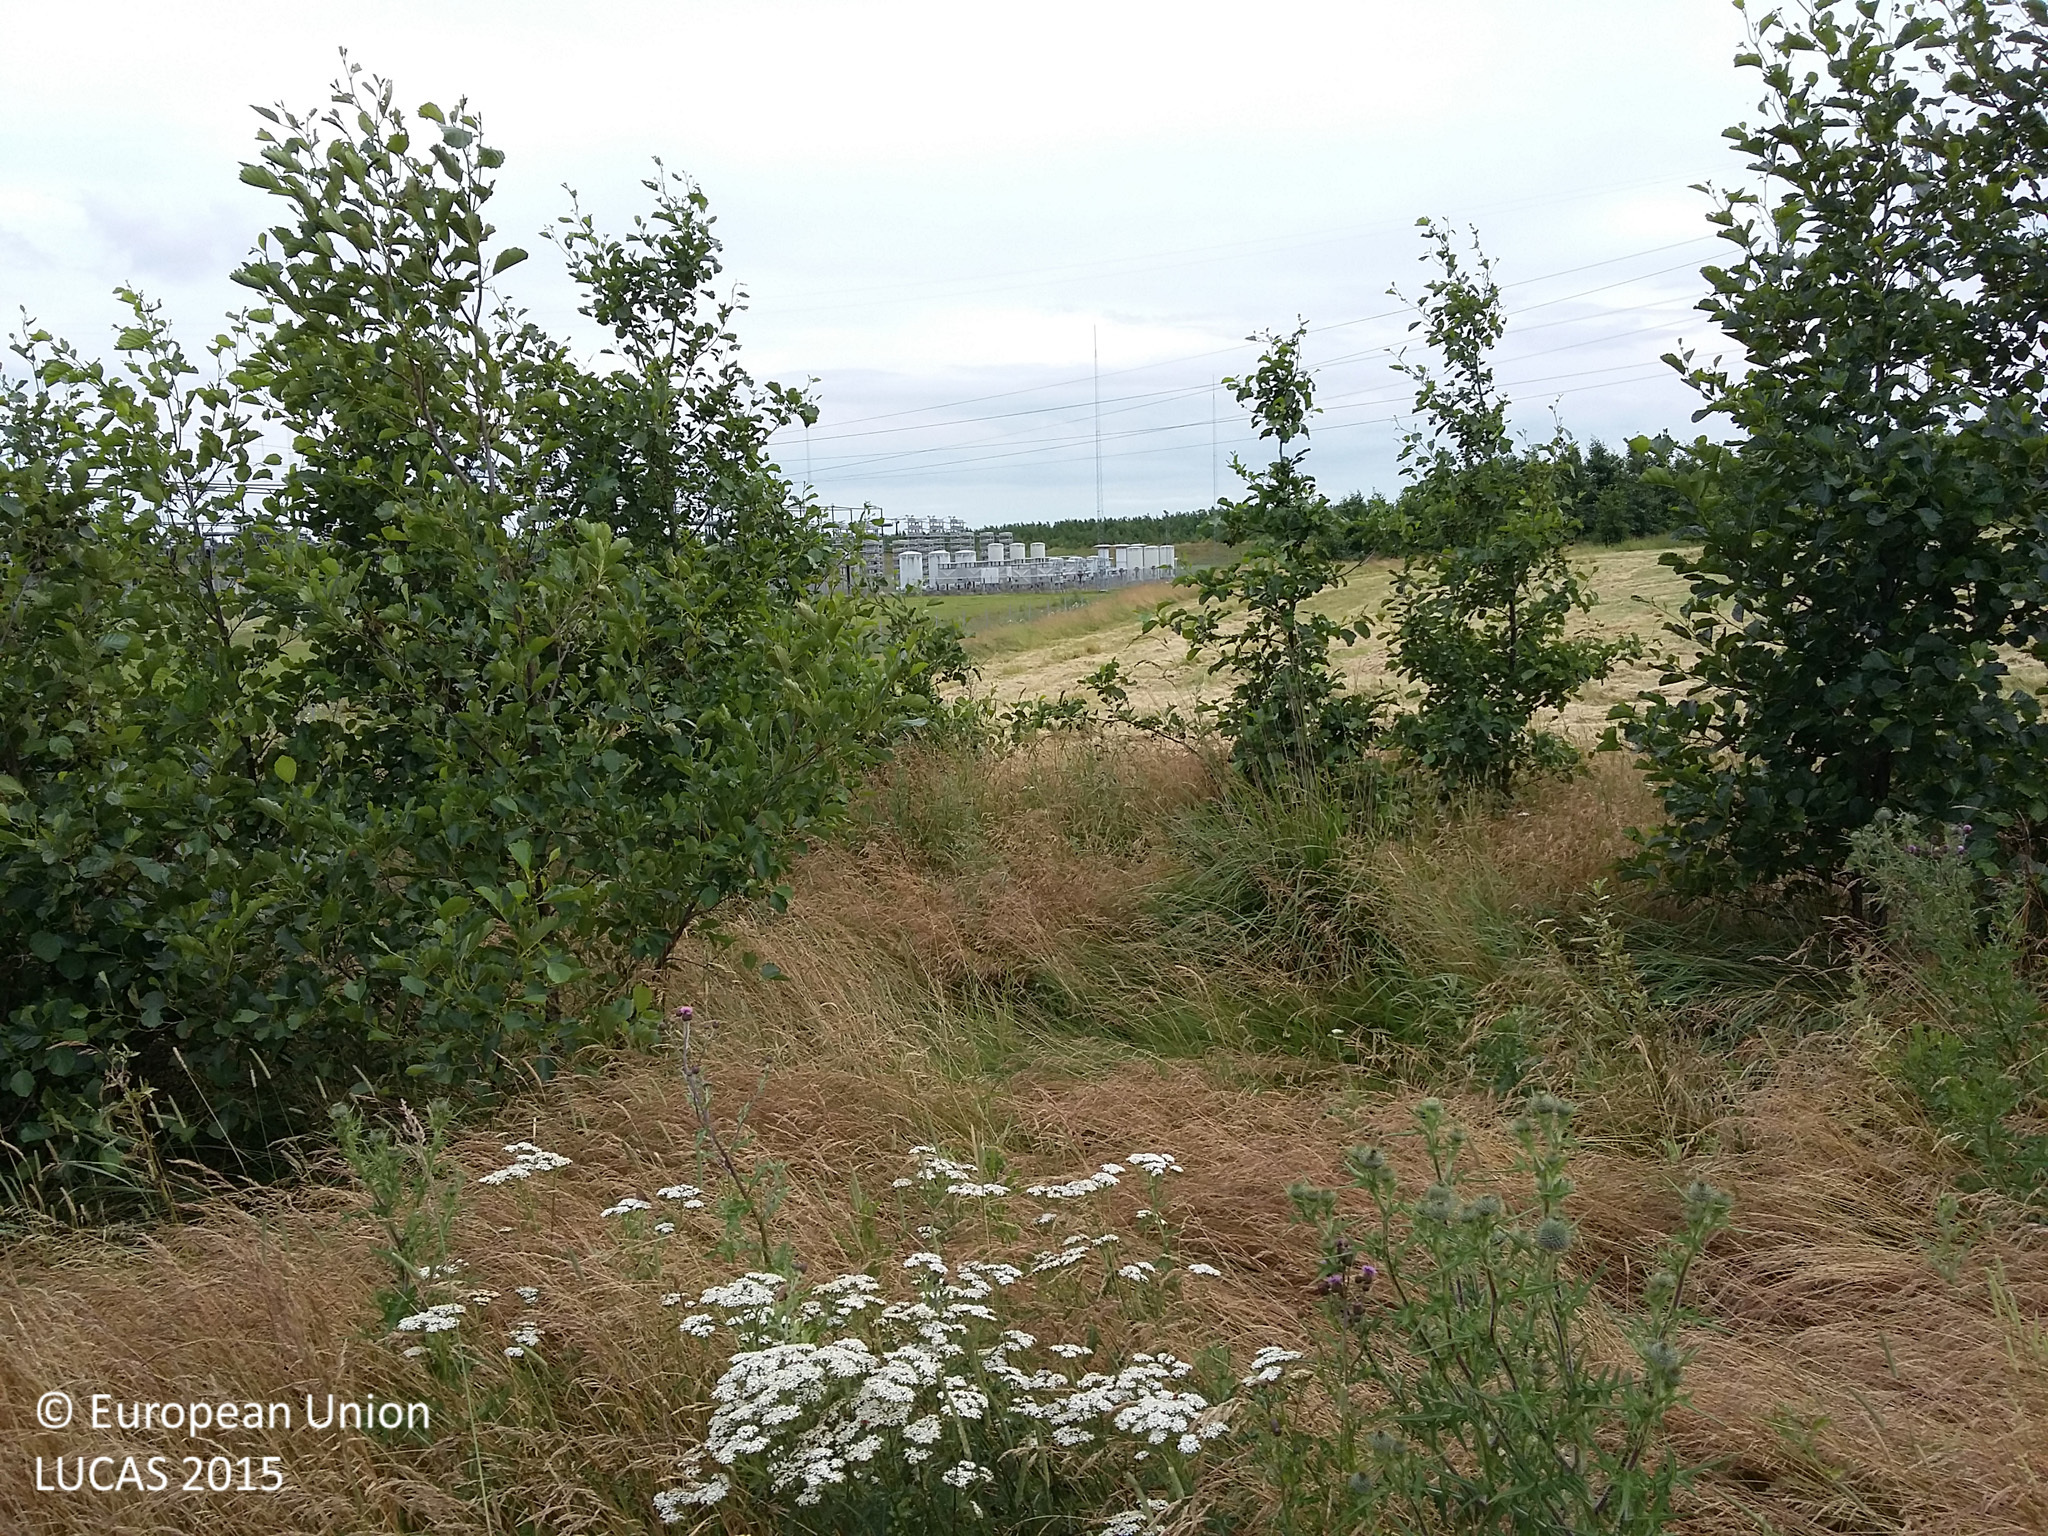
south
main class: Woodland
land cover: Broadleaved woodland
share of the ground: 25 - 50 %
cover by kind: herbaceous plants 65 %, broadleaved forest trees 35 %
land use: Agriculture (excluding fallow land and kitchen gardens)
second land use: Amenities, museums, leisure
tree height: < 5 m
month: July
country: DK
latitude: 55.5338
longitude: 11.3139
